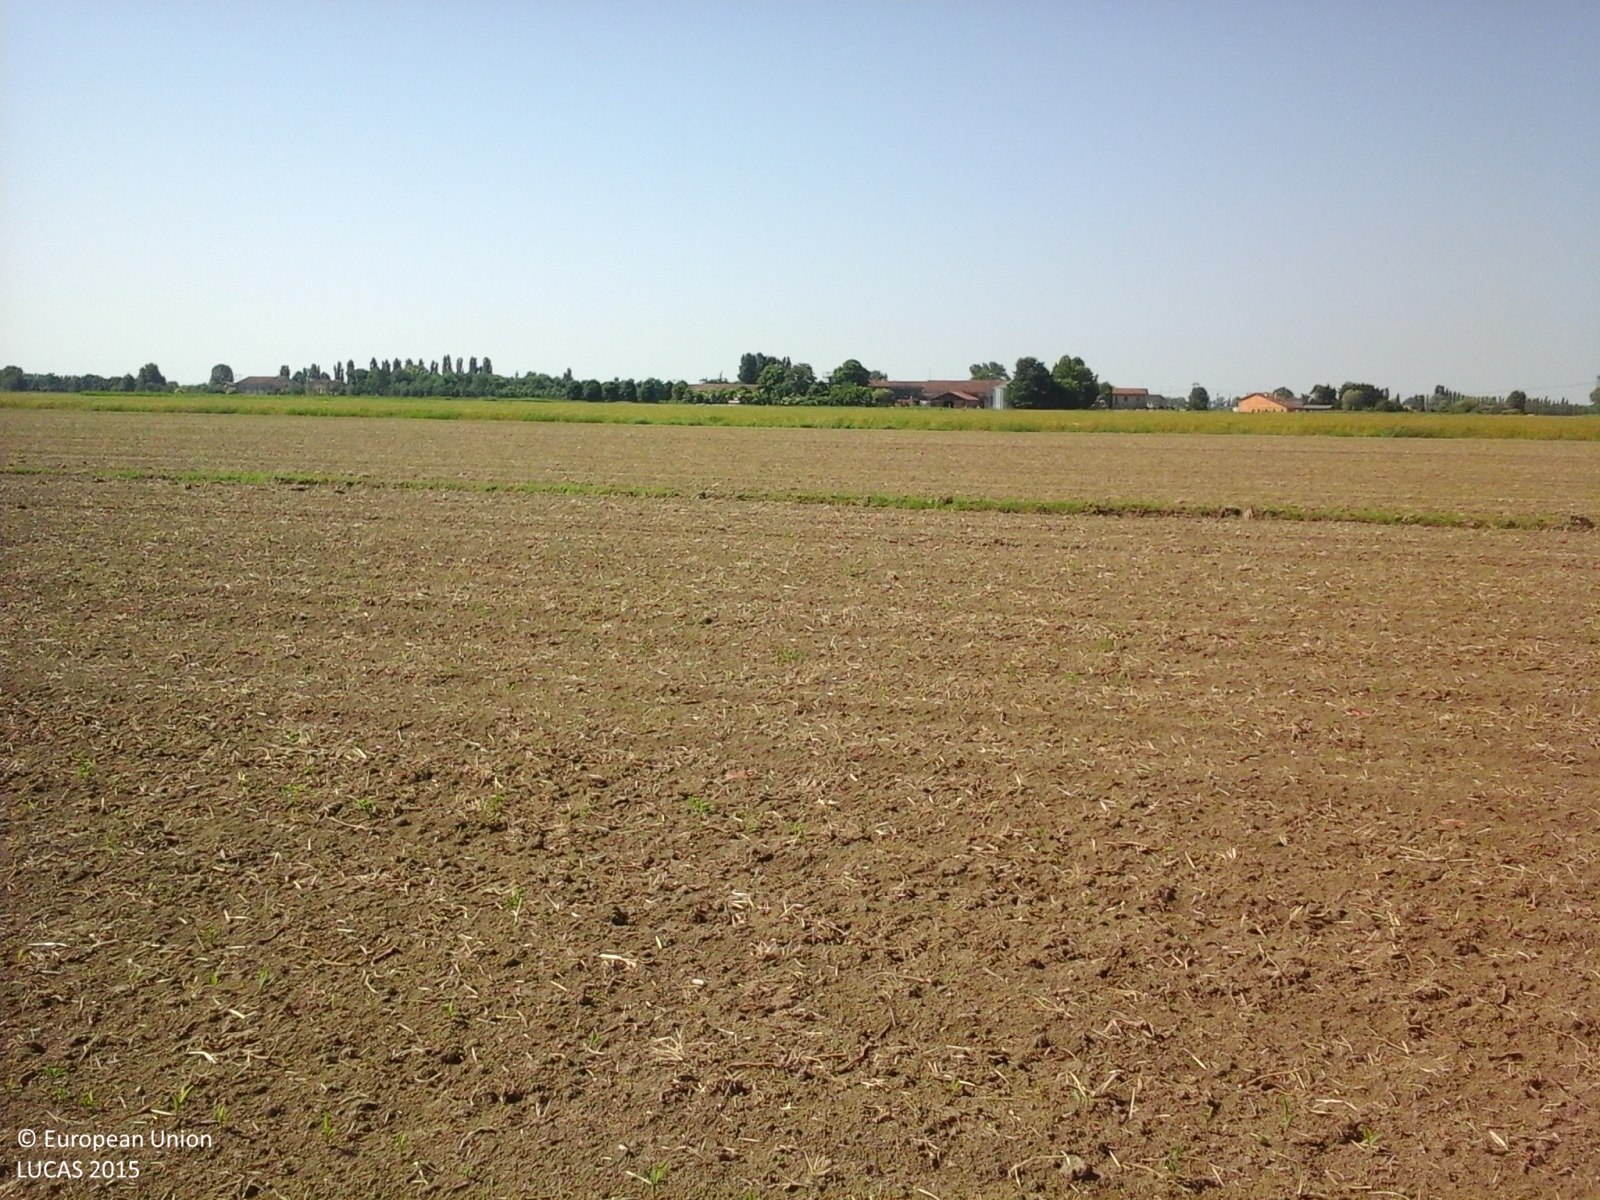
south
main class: Cropland
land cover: Maize
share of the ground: < 10 %
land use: Agriculture (excluding fallow land and kitchen gardens)
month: May
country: IT
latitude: 45.1574
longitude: 10.9777
